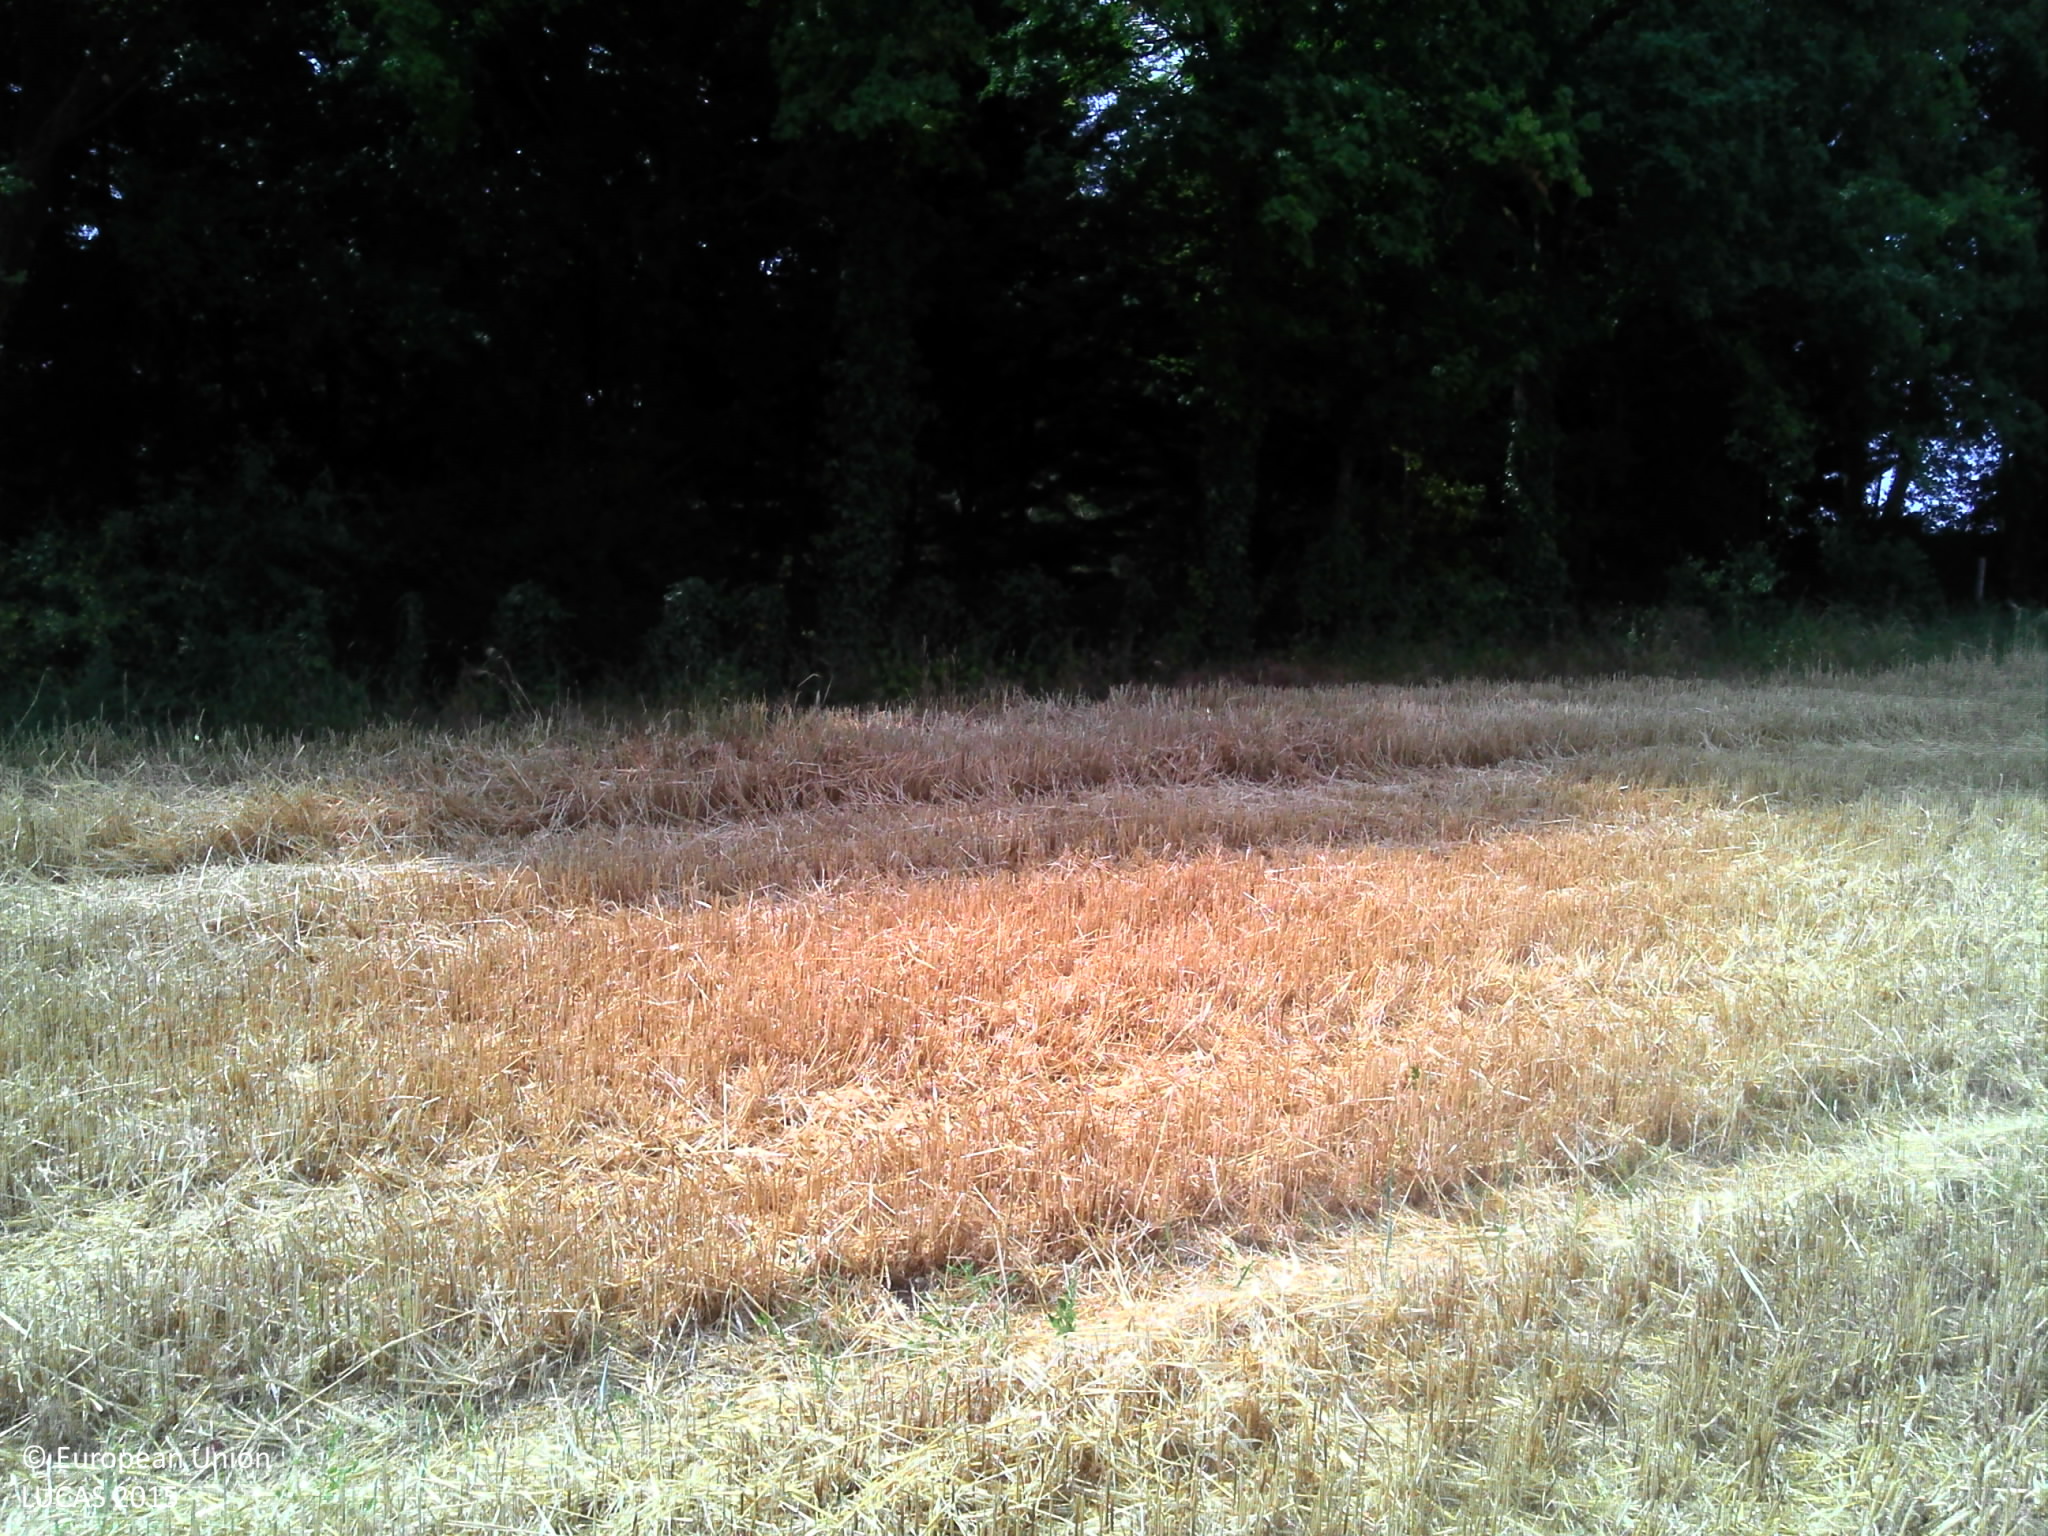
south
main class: Cropland
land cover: Barley
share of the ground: > 75 %
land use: Agriculture (excluding fallow land and kitchen gardens)
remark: Harvested field
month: July
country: FR
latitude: 47.6517
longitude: 3.4855
